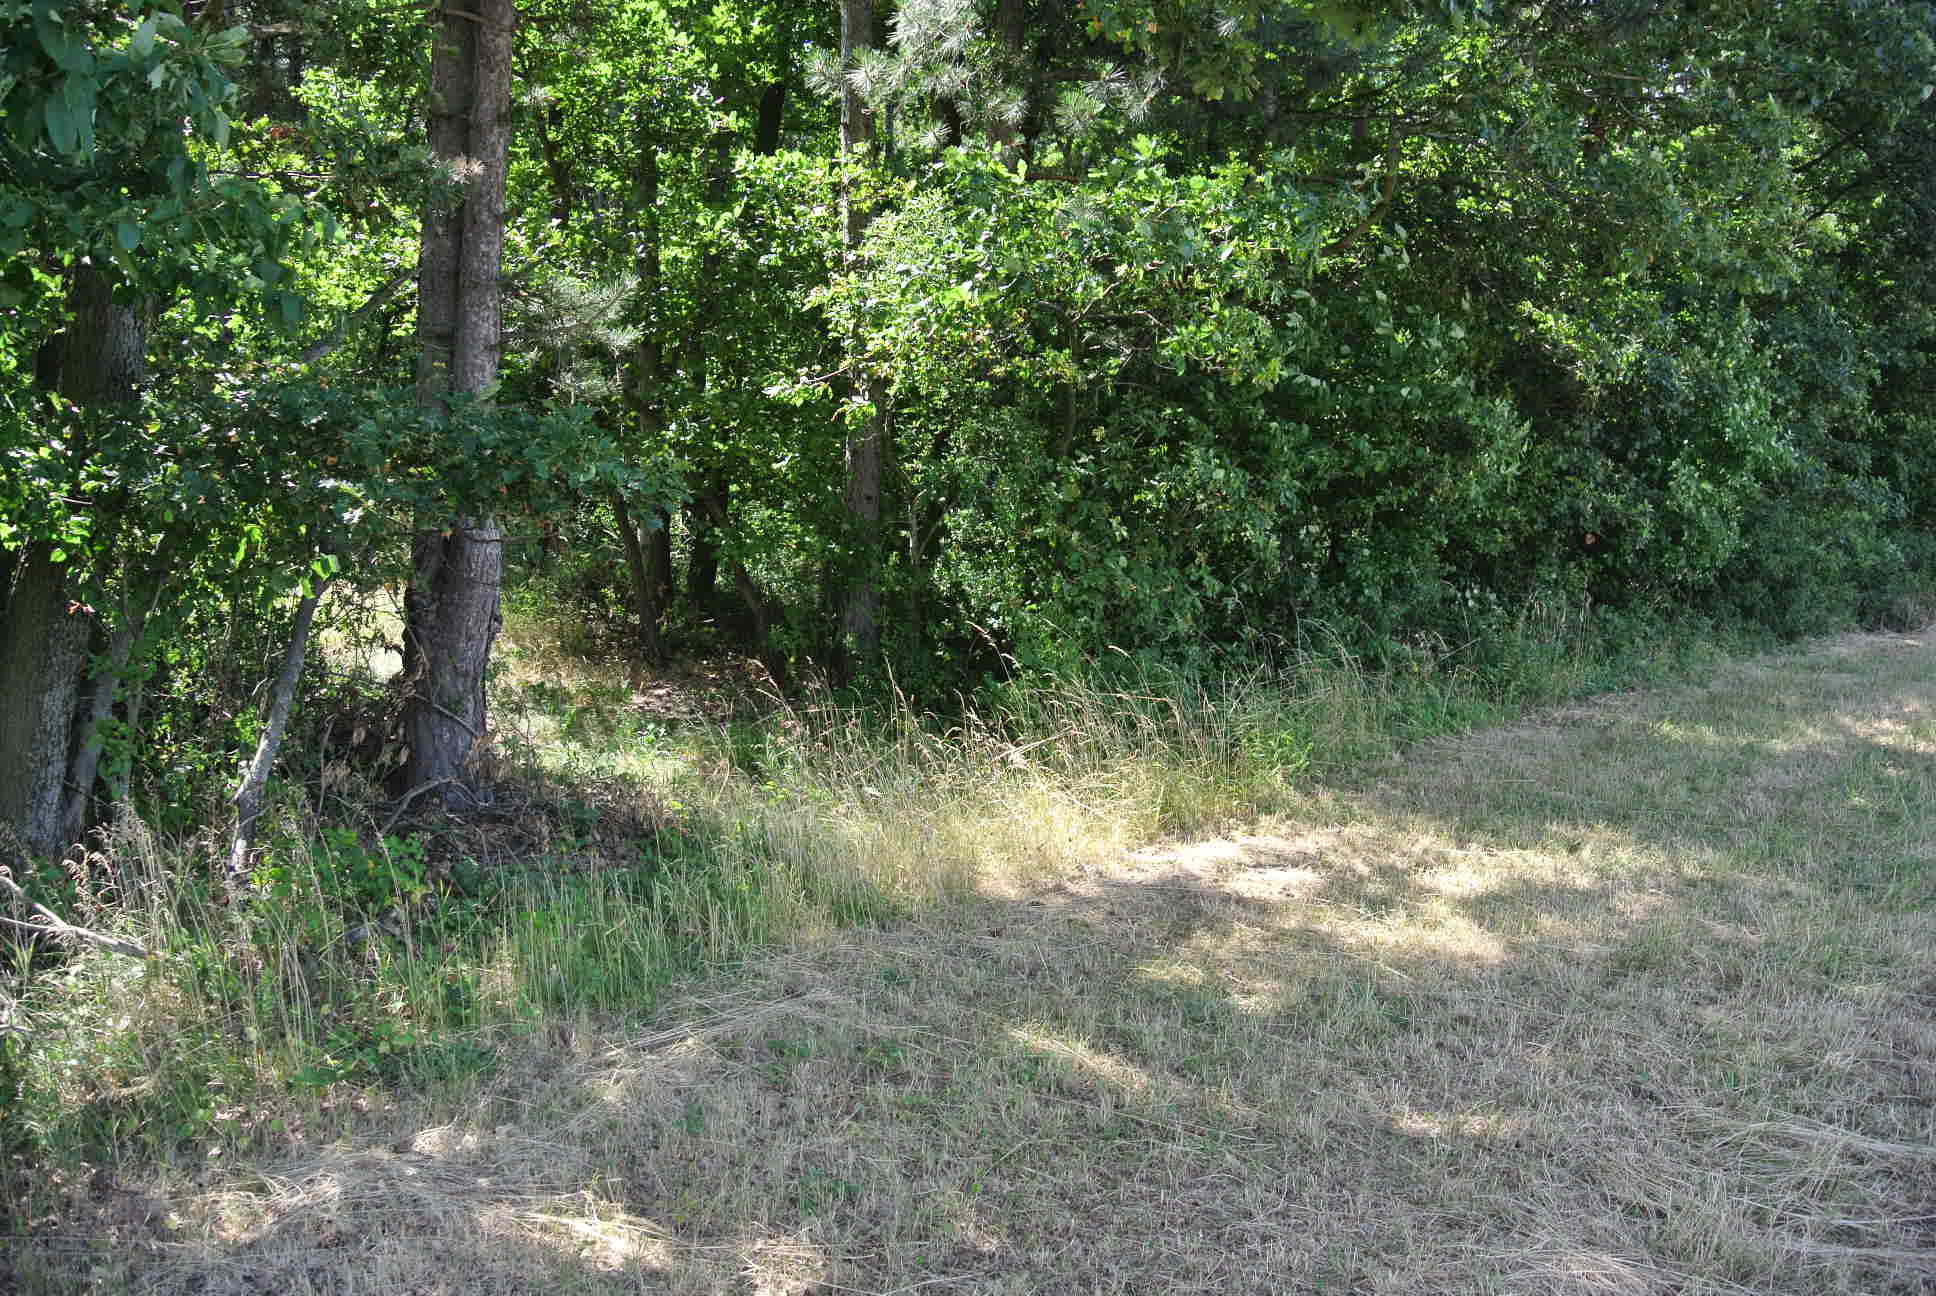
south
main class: Grassland
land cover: Grassland without tree/shrub cover
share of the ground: > 75 %
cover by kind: herbaceous plants 100 %
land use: Agriculture (excluding fallow land and kitchen gardens)
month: July
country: AT
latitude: 47.7444
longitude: 16.4728
